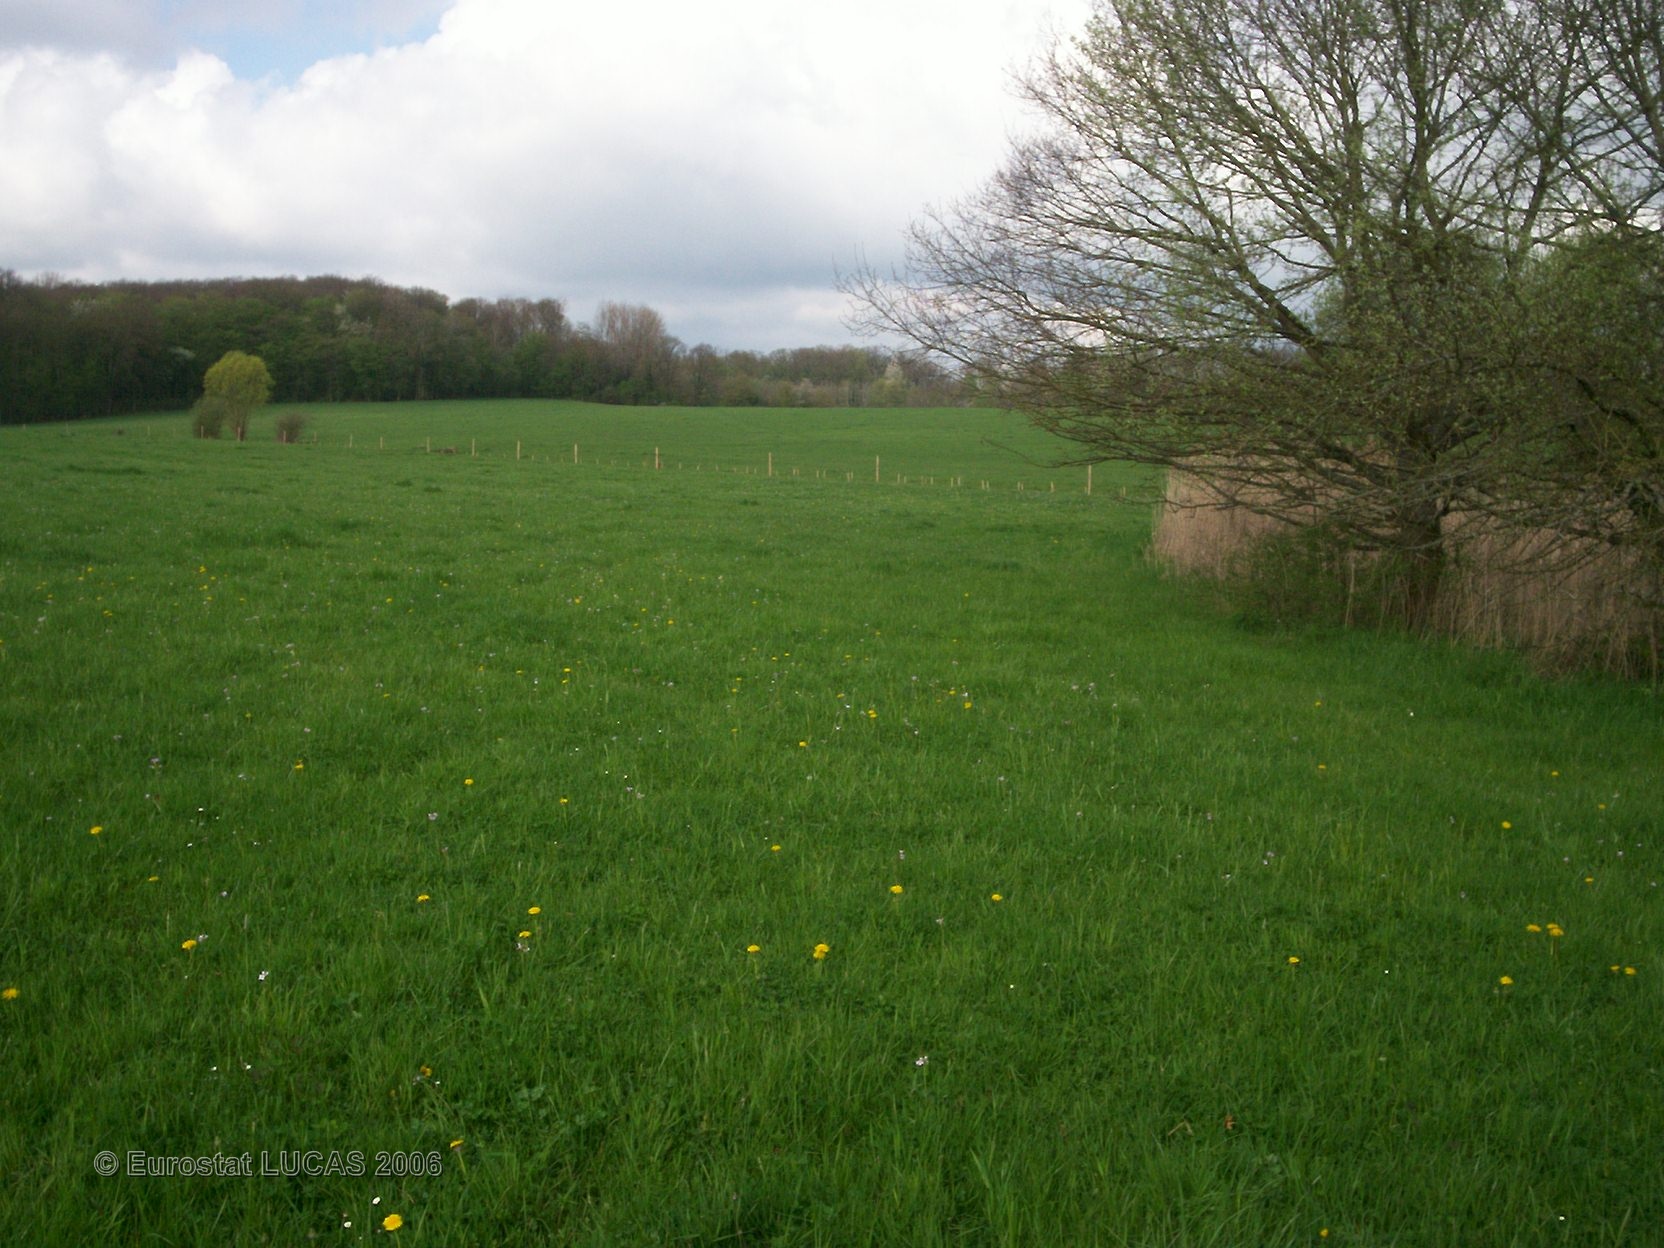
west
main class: Grassland
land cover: Grassland without tree/shrub cover
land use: Agriculture (excluding fallow land and kitchen gardens)
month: April
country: FR
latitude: 48.7878
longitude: 6.7474
